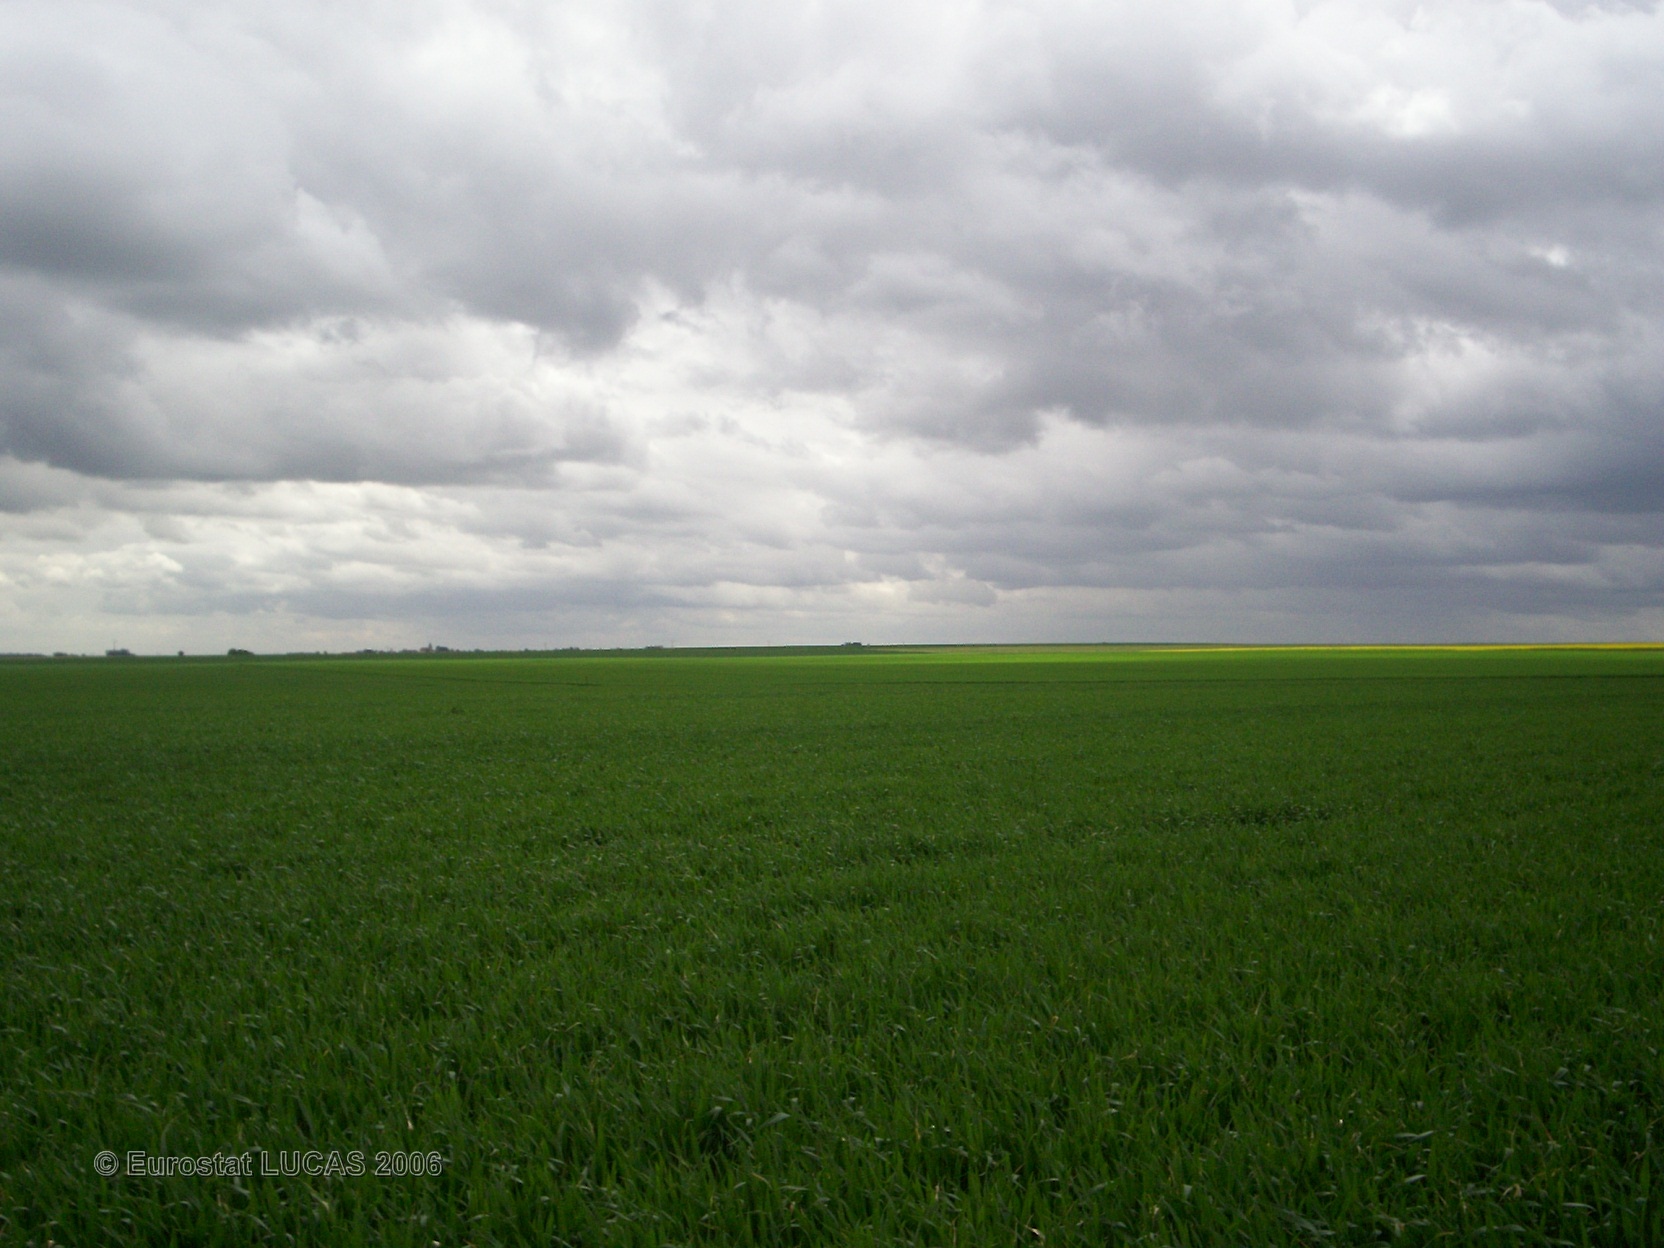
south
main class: Cropland
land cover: Common wheat
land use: Agriculture (excluding fallow land and kitchen gardens)
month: May
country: FR
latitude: 49.1417
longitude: 2.7657
